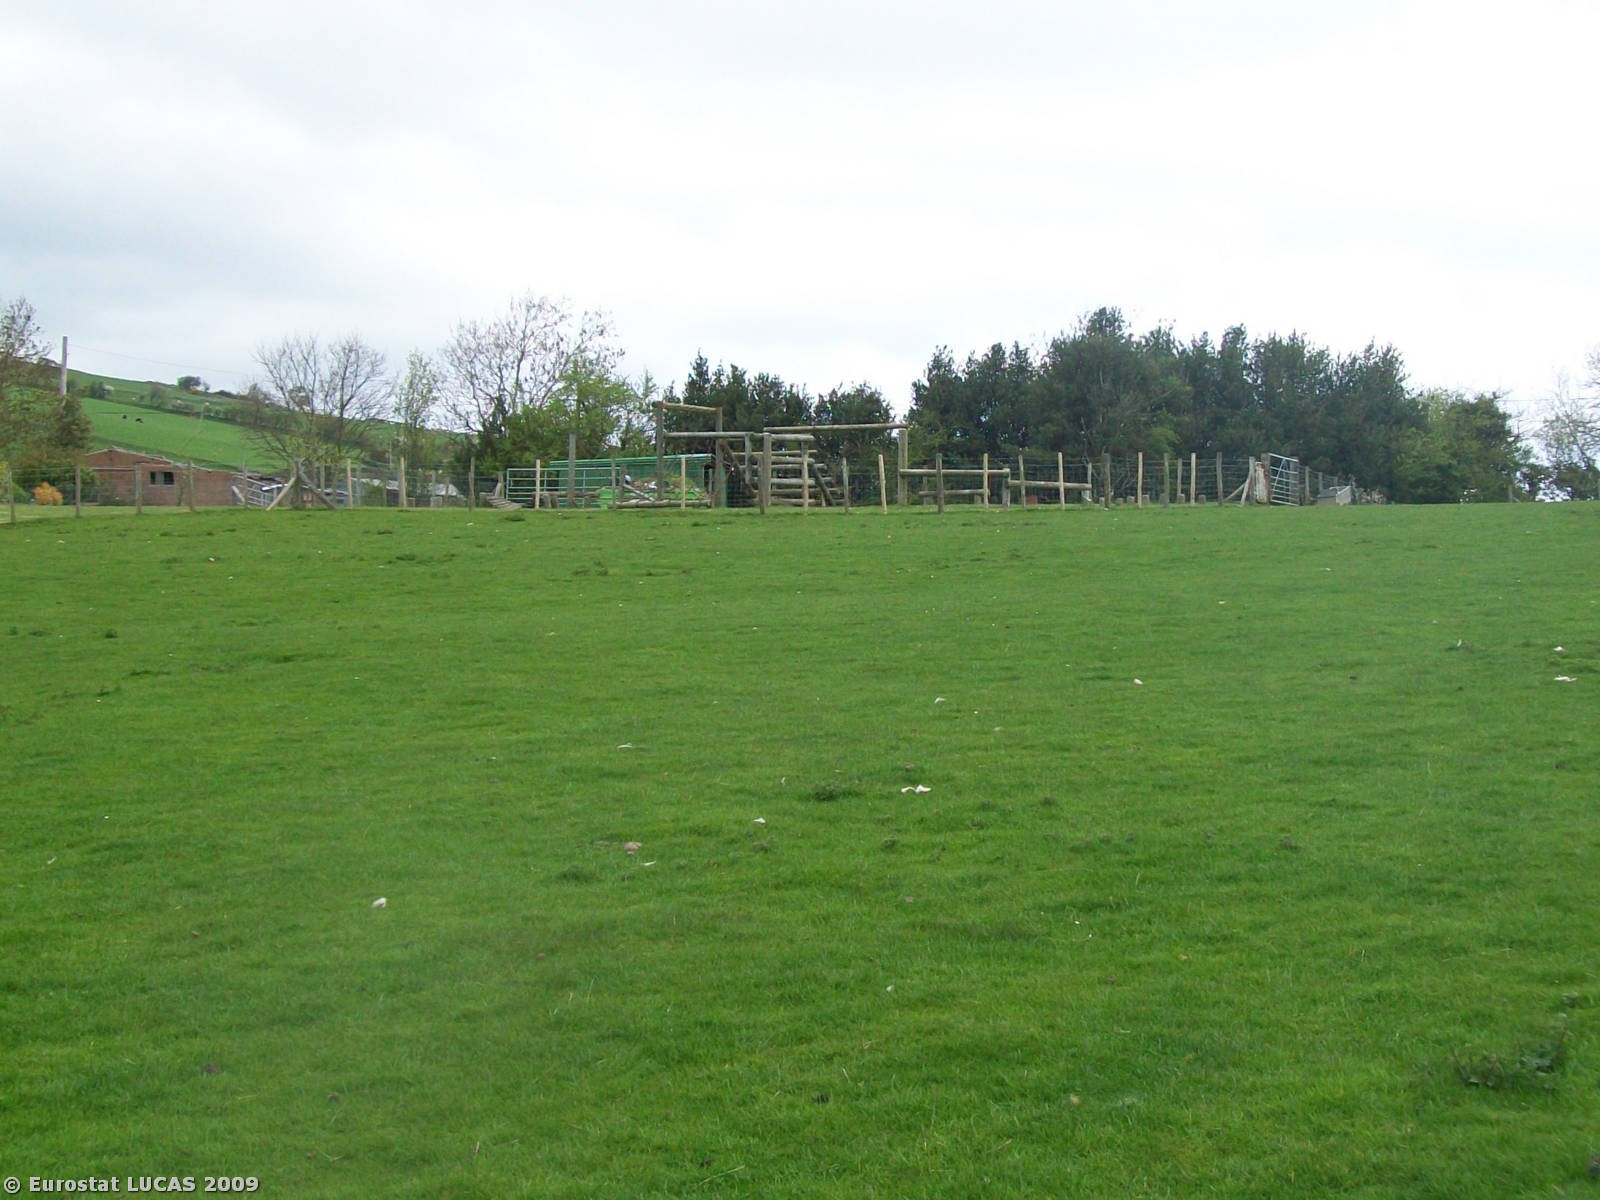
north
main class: Grassland
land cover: Grassland without tree/shrub cover
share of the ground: > 75 %
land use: Agriculture (excluding fallow land and kitchen gardens)
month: April
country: GB
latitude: 53.1701
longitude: -3.5027
